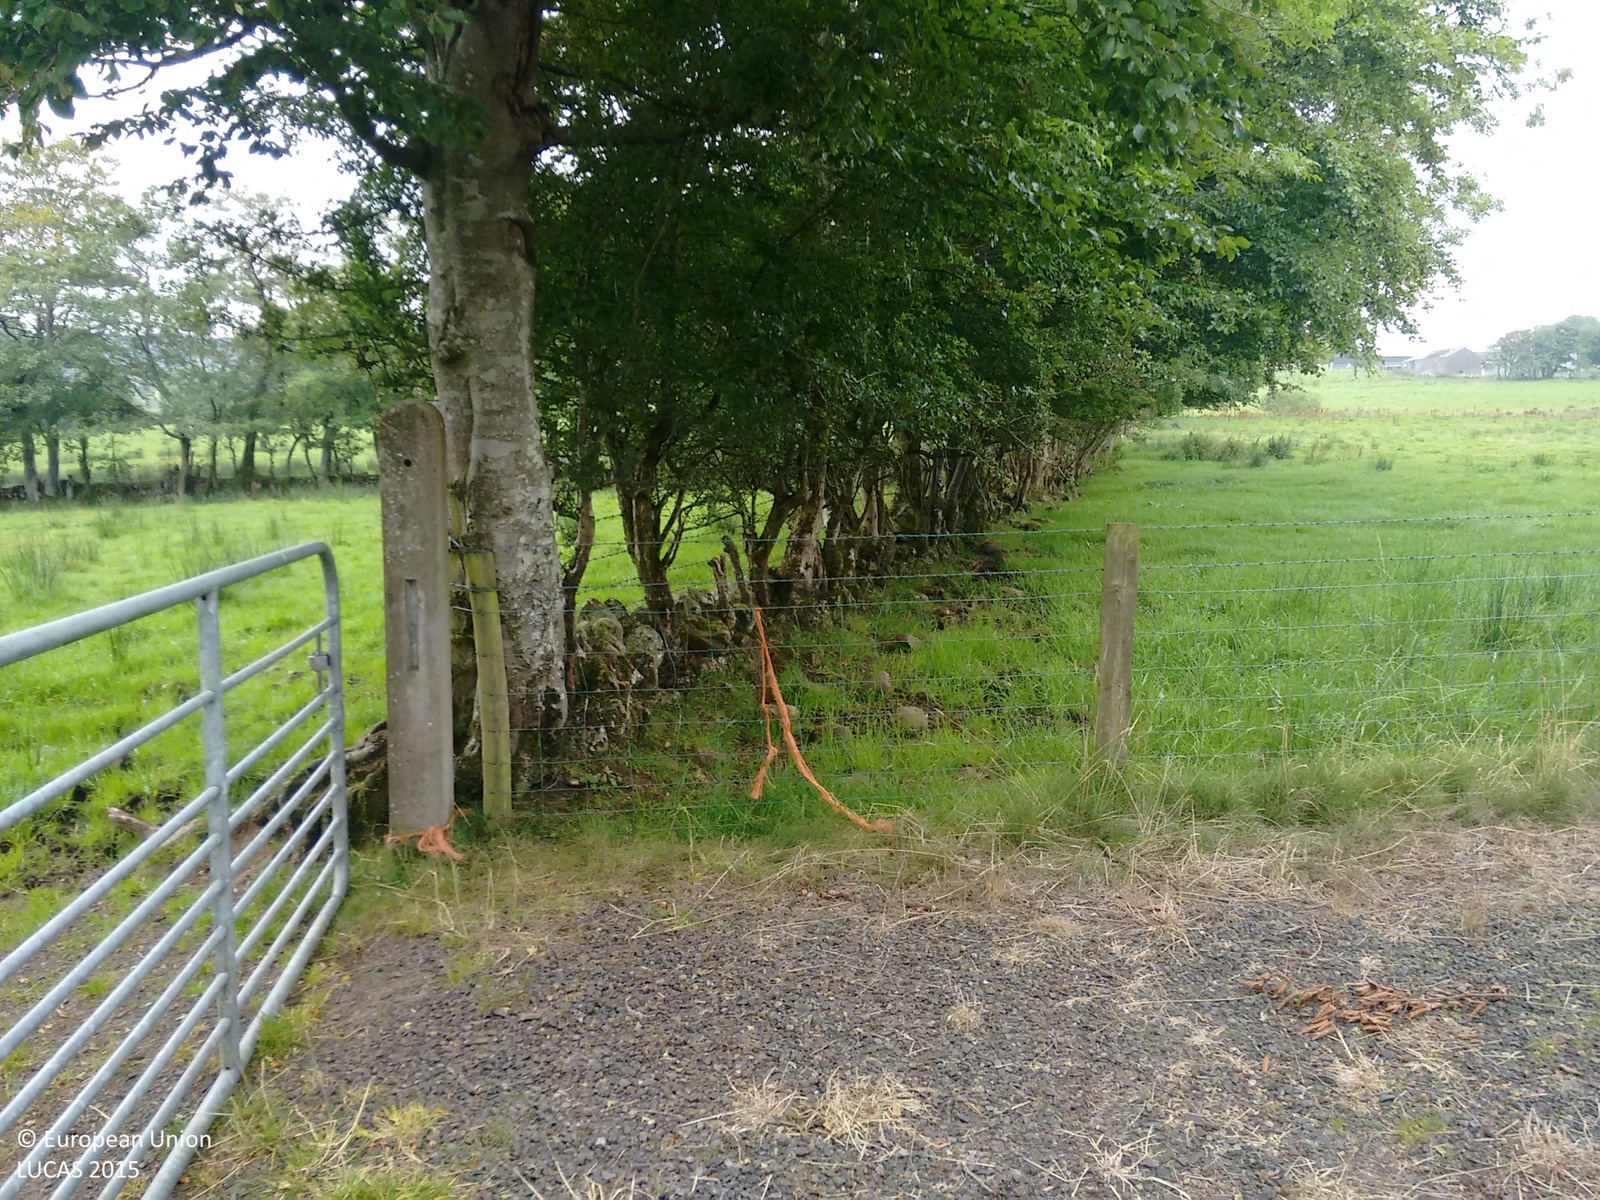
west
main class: Grassland
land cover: Grassland without tree/shrub cover
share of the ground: > 75 %
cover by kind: herbaceous plants 100 %
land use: Agriculture (excluding fallow land and kitchen gardens)
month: September
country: GB
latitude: 54.7859
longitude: -6.0174
